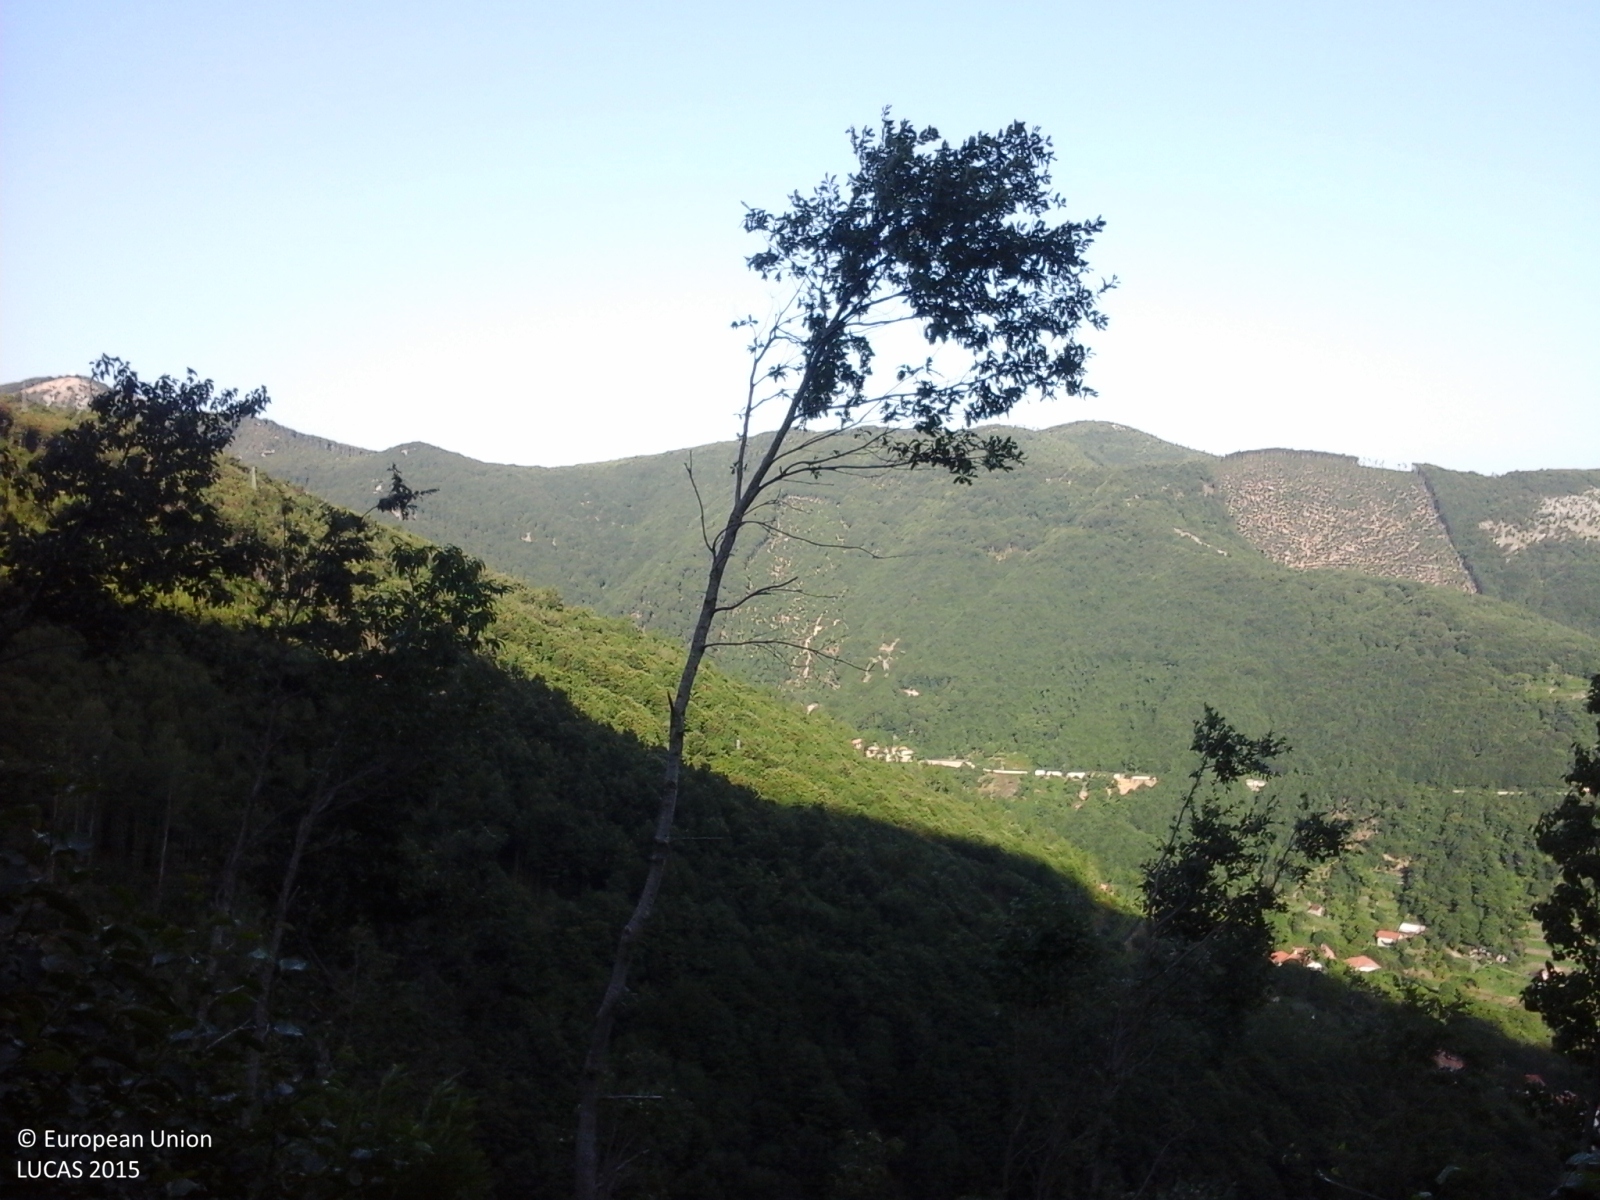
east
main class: Woodland
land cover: Broadleaved woodland
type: thermophilous deciduous forest
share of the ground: > 75 %
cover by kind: broadleaved forest trees 100 %
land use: Forestry
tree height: > 5 m
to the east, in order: Broadleaved woodland; Tracks; Broadleaved woodland; Rivers and streams; Broadleaved woodland; Rivers and streams; Broadleaved woodland
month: September
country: IT
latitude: 40.6688
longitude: 14.5586
